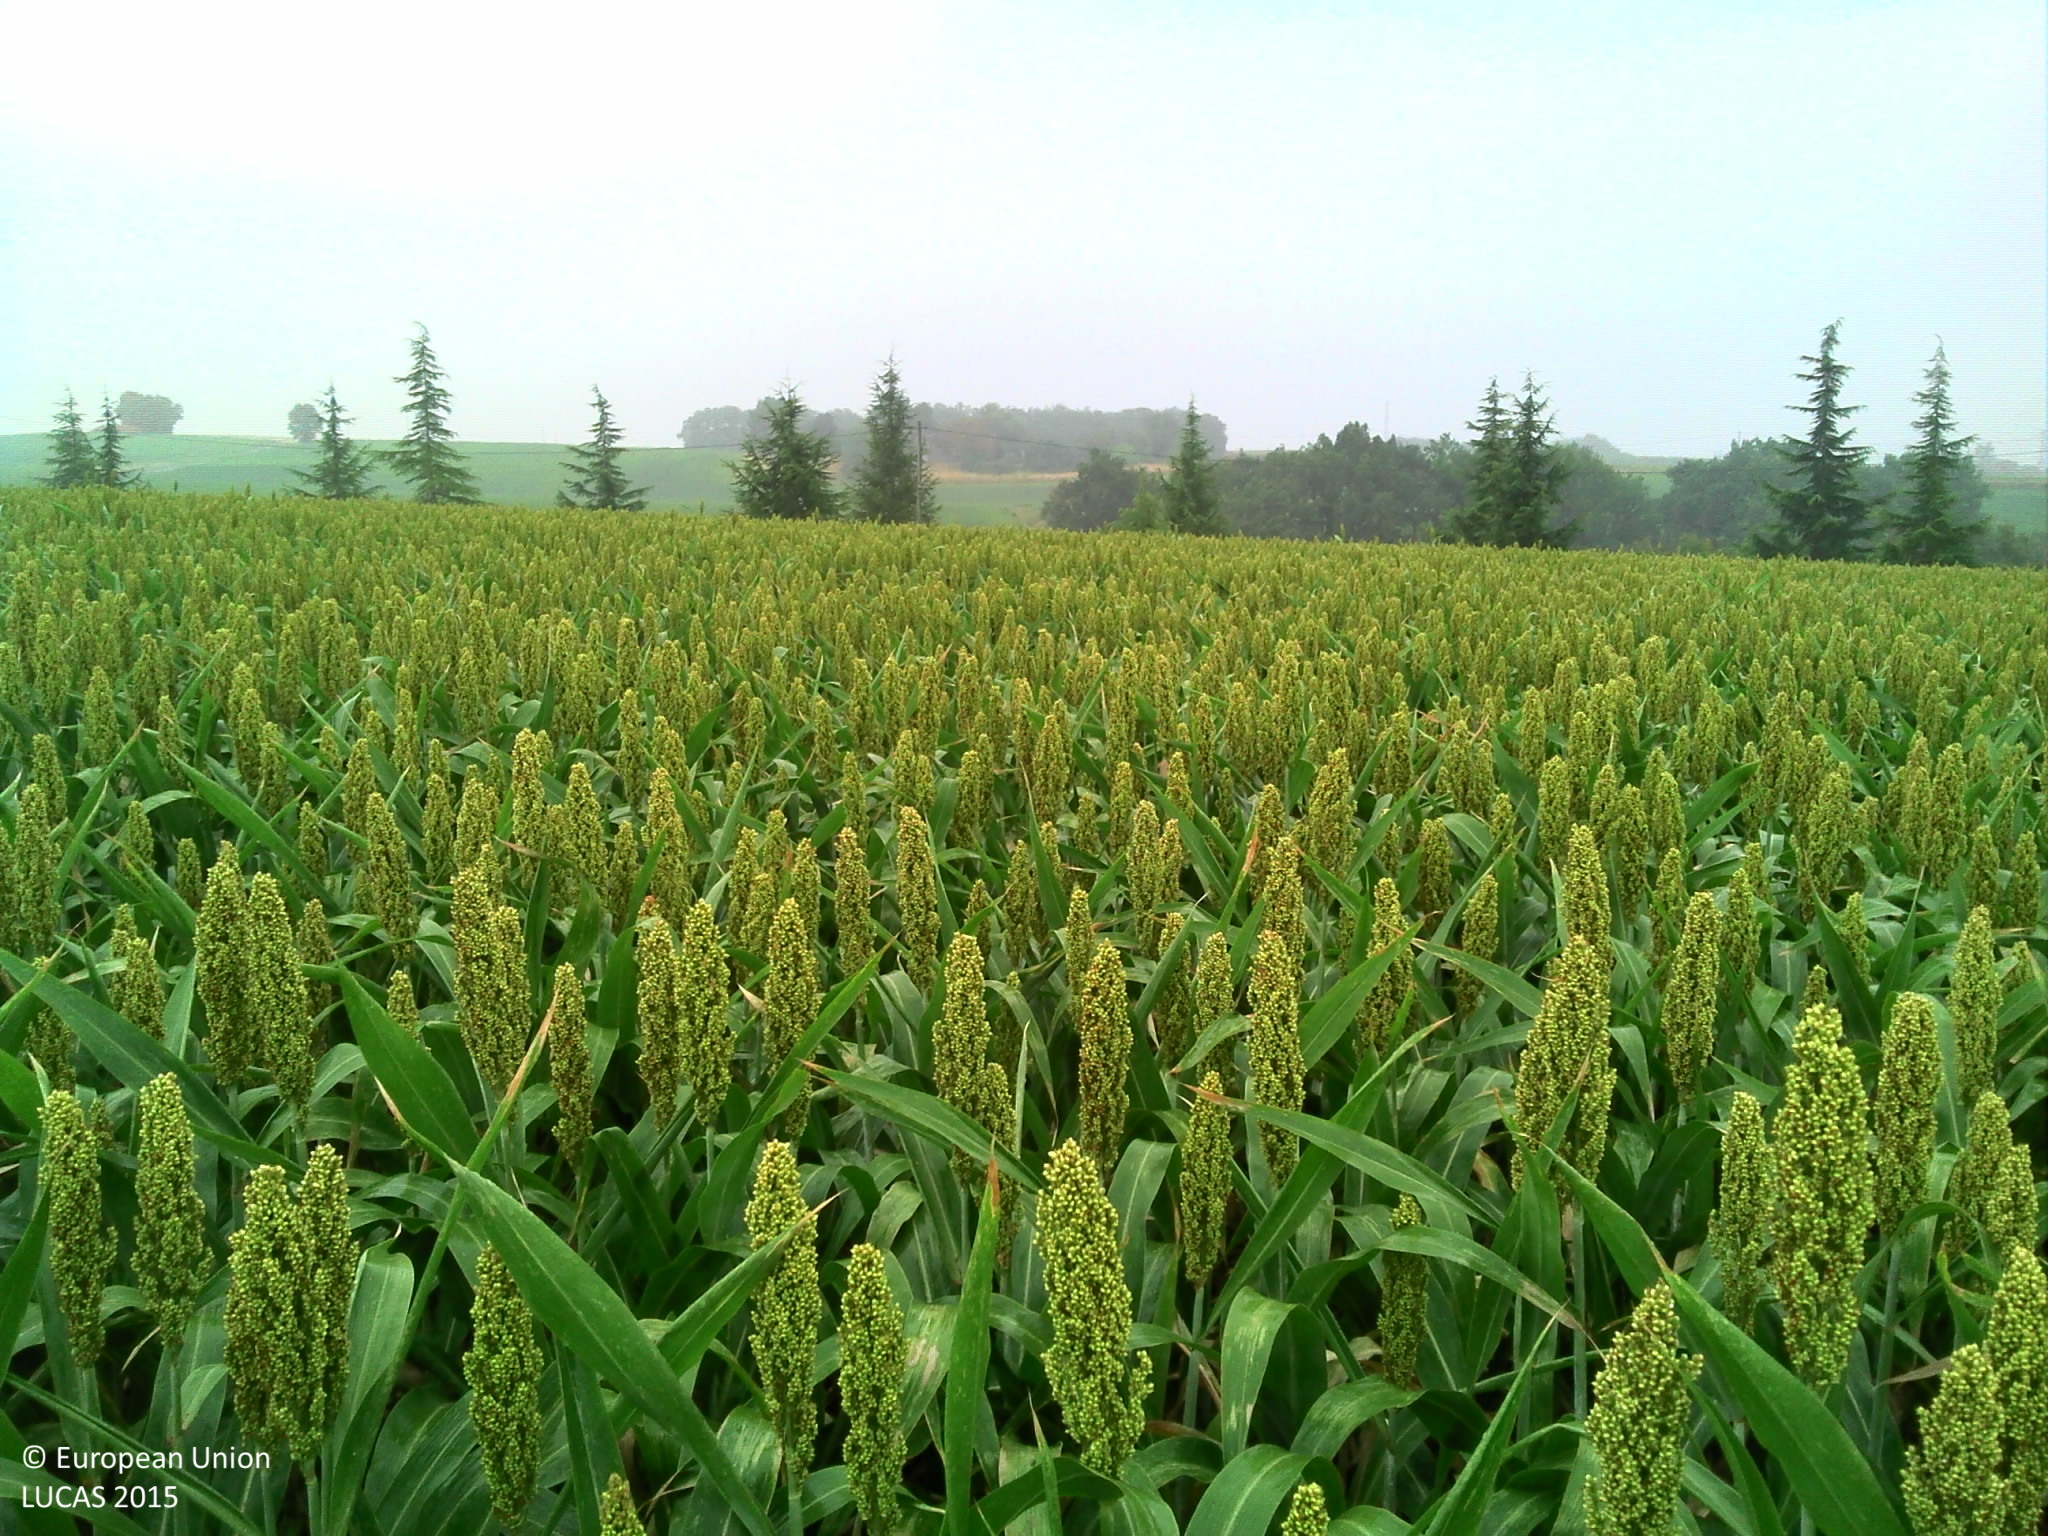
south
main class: Cropland
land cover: Other cereals
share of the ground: > 75 %
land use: Agriculture (excluding fallow land and kitchen gardens)
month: July
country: FR
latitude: 44.1816
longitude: 0.8521
